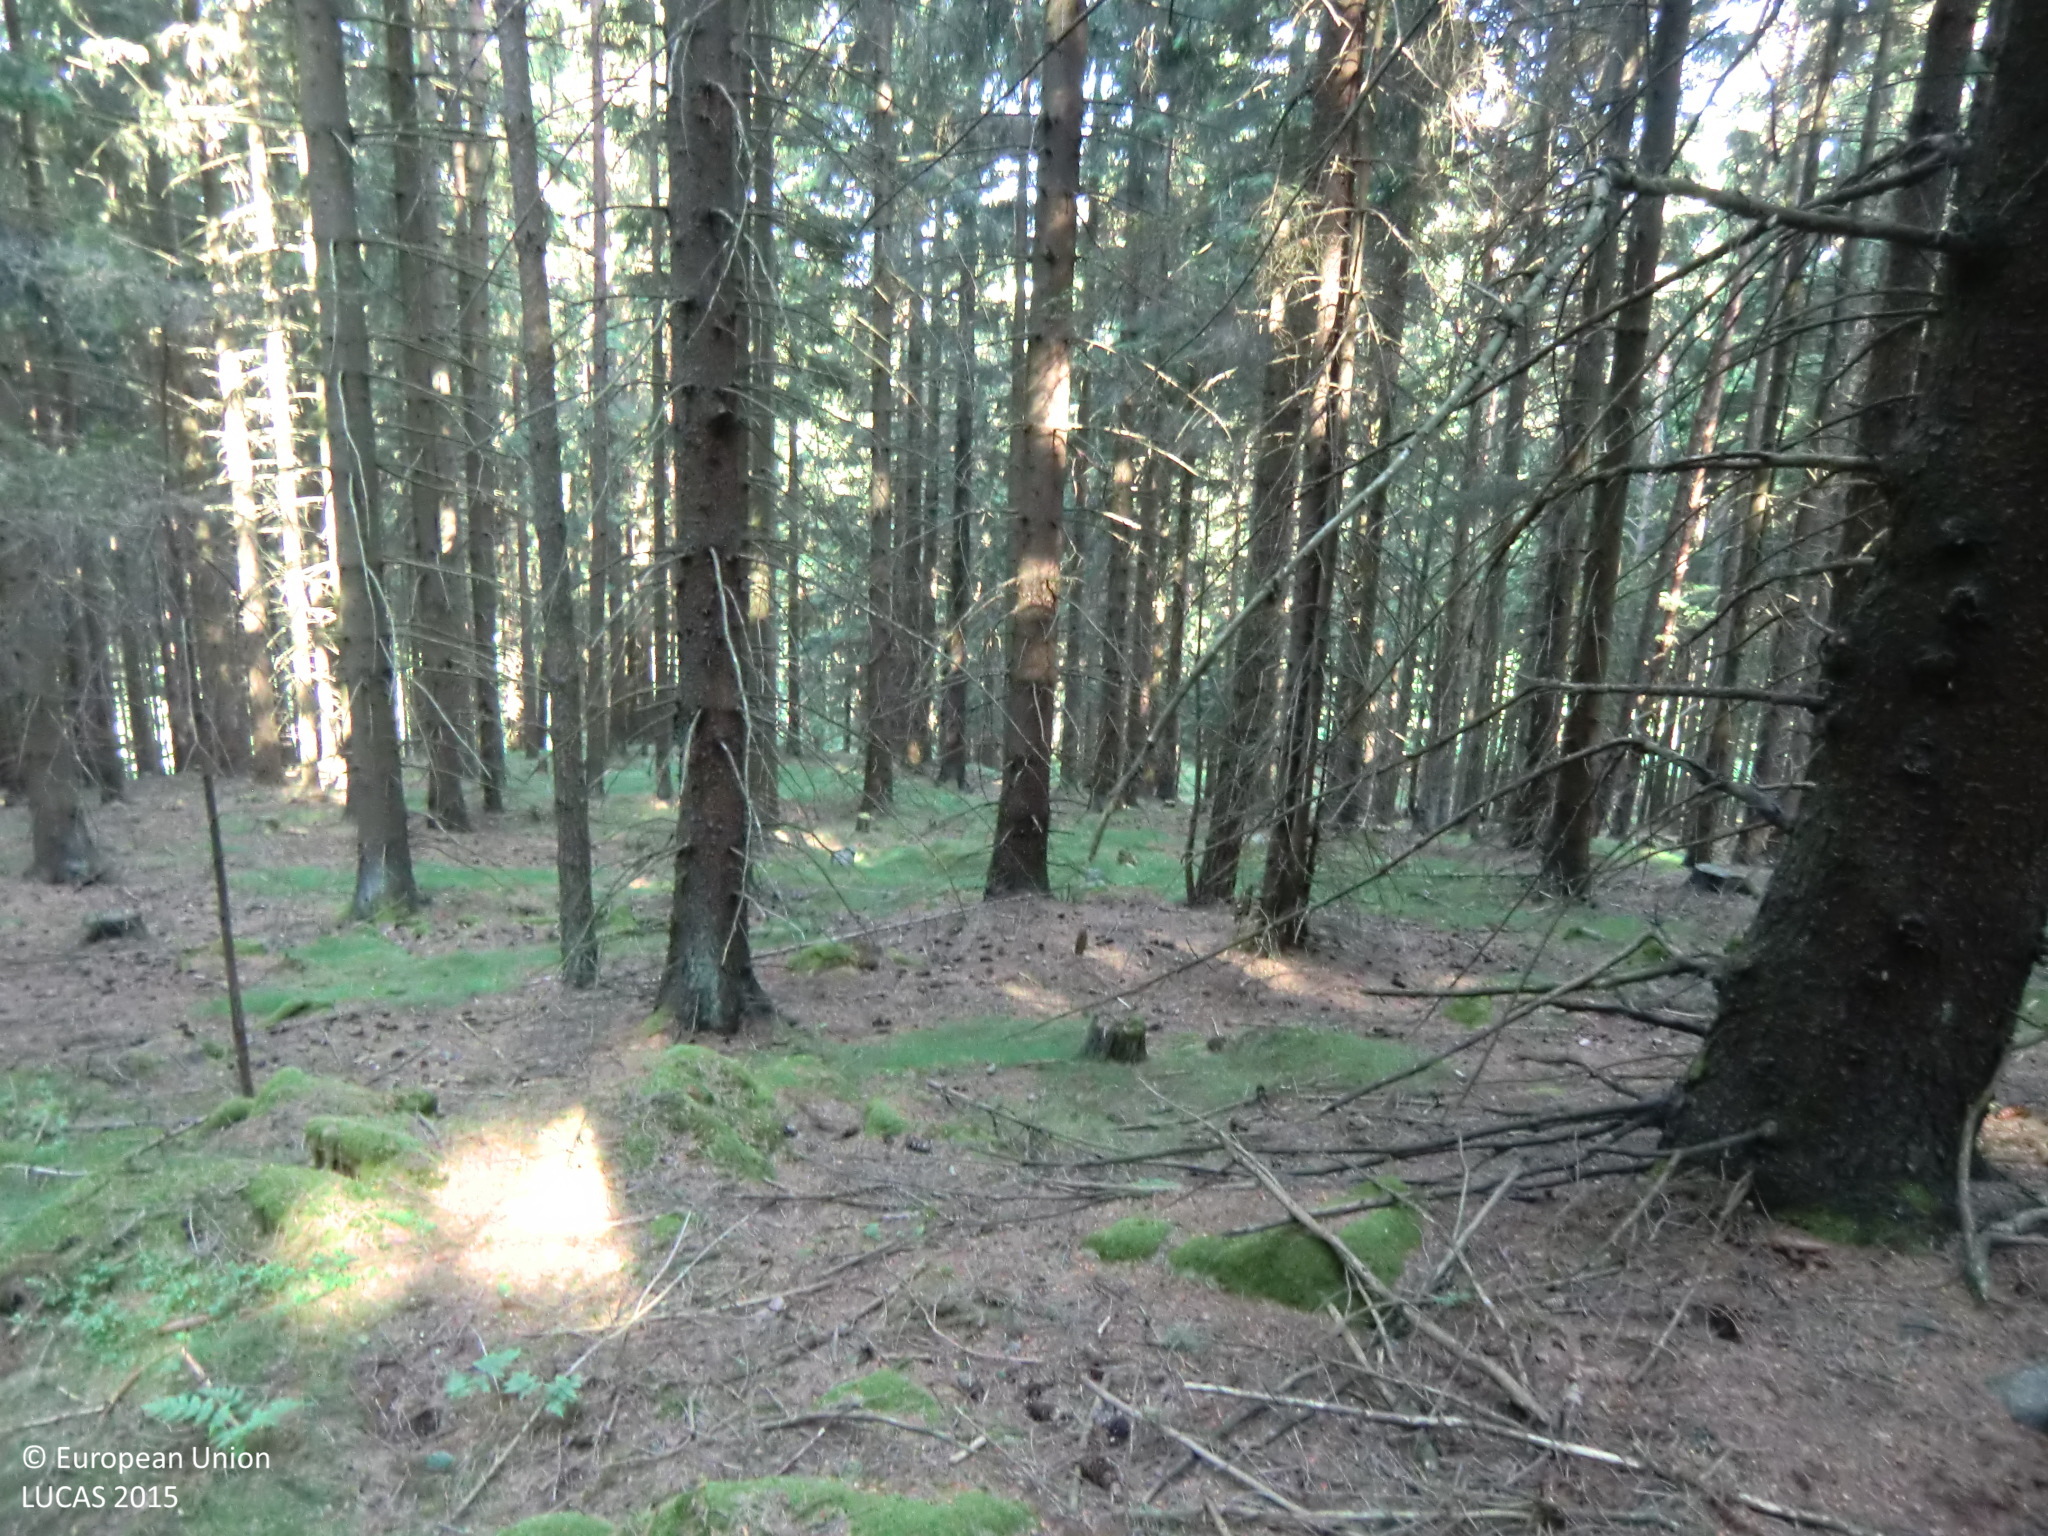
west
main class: Woodland
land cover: Spruce dominated coniferous woodland
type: hemiboreal forest and nemoral coniferous forest and mixed broadleaved-coniferous forest
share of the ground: > 75 %
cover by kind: coniferous forest trees 80 %, herbaceous plants 10 %, lichens and mosses 5 %, unconsolidated bare surface 5 %
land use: Forestry
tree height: > 5 m
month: June
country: AT
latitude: 48.4603
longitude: 14.3955
